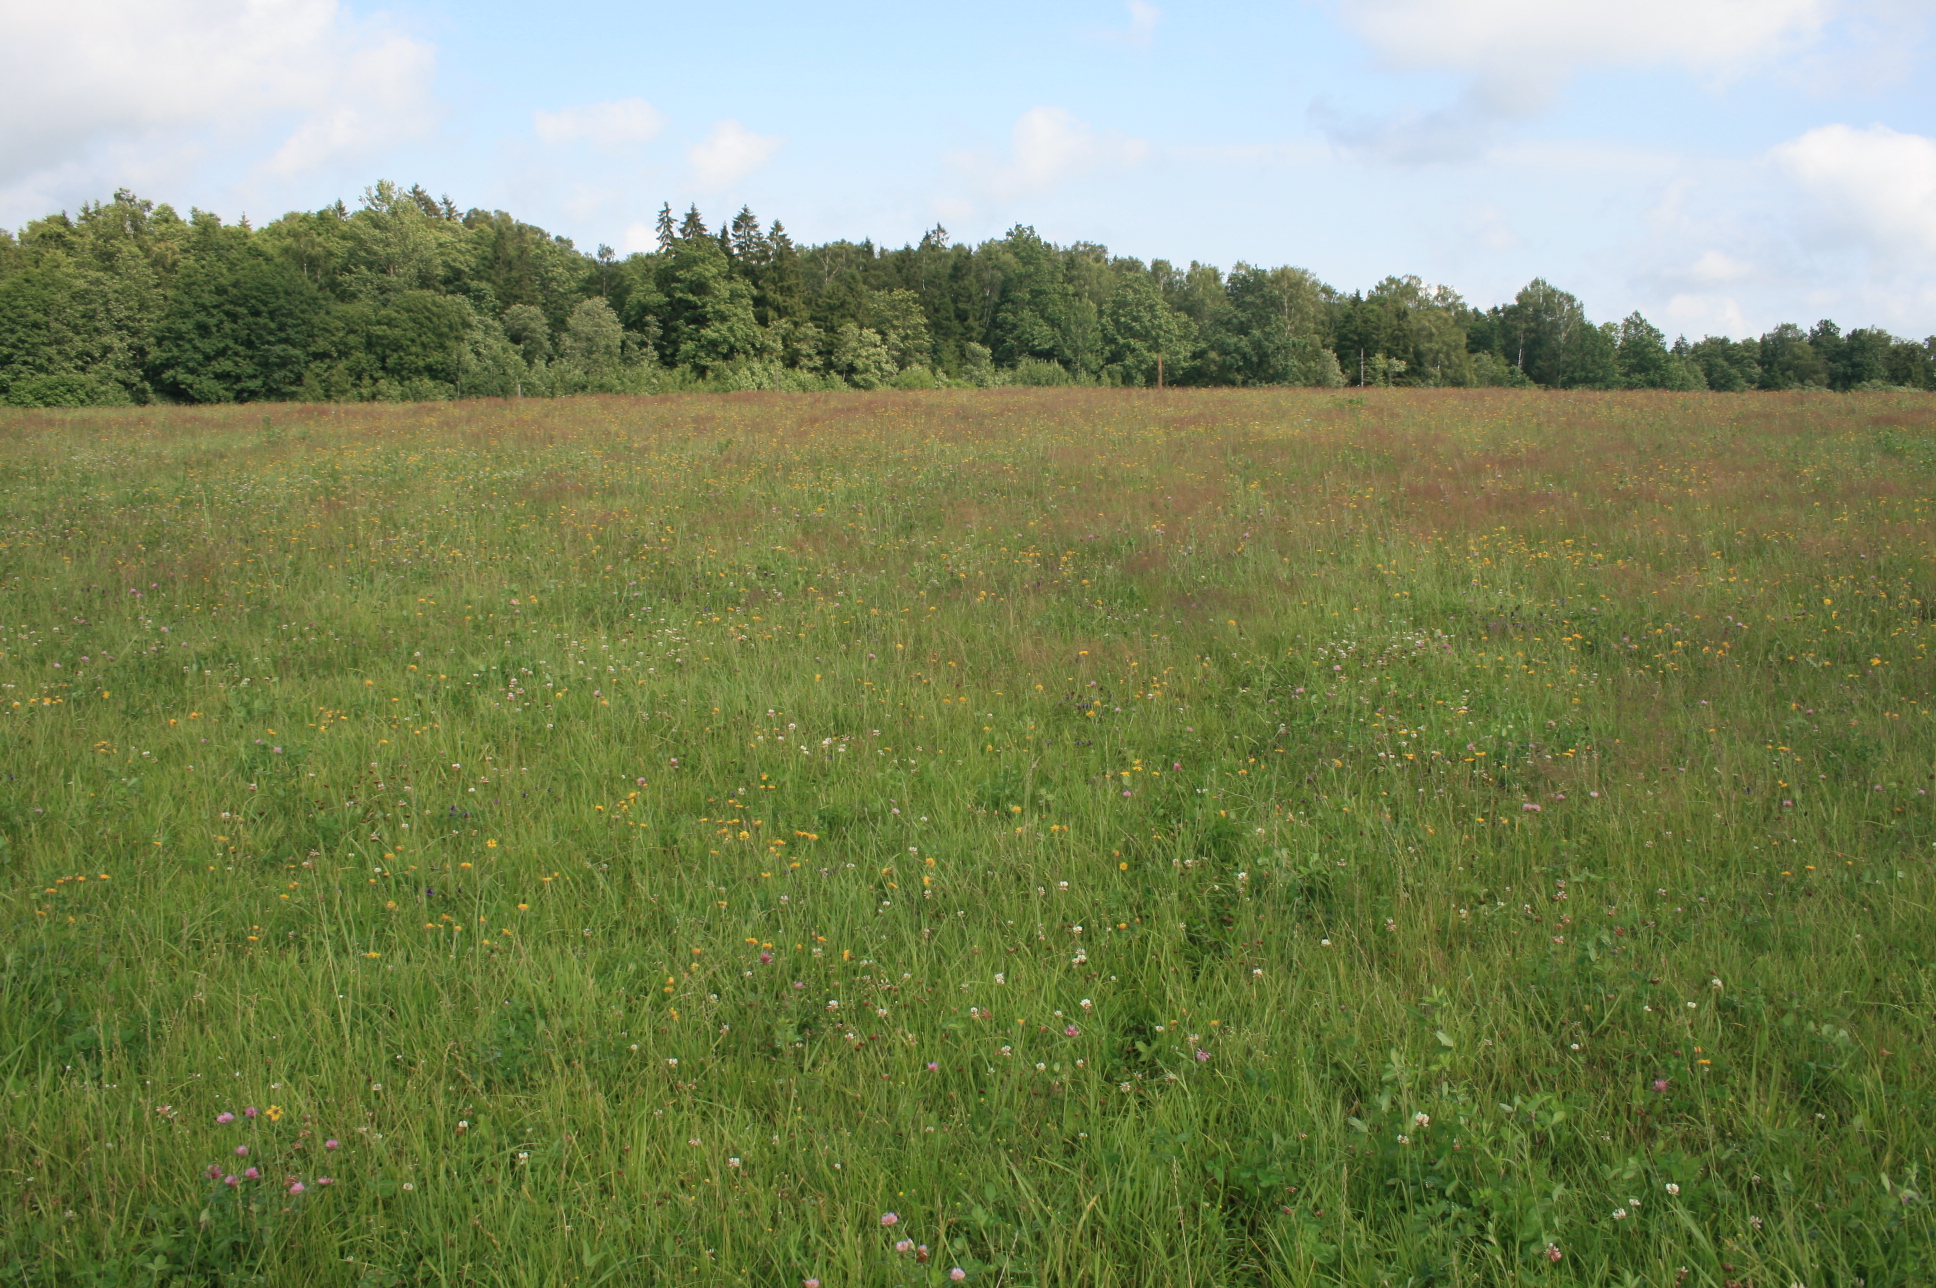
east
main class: Grassland
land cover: Grassland without tree/shrub cover
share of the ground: > 75 %
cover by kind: herbaceous plants 100 %
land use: Agriculture (excluding fallow land and kitchen gardens)
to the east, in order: Grassland without tree/shrub cover; Fences; Grassland without tree/shrub cover; Fences; Broadleaved woodland; Spruce dominated mixed woodland
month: July
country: LT
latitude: 55.5299
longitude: 21.8214
